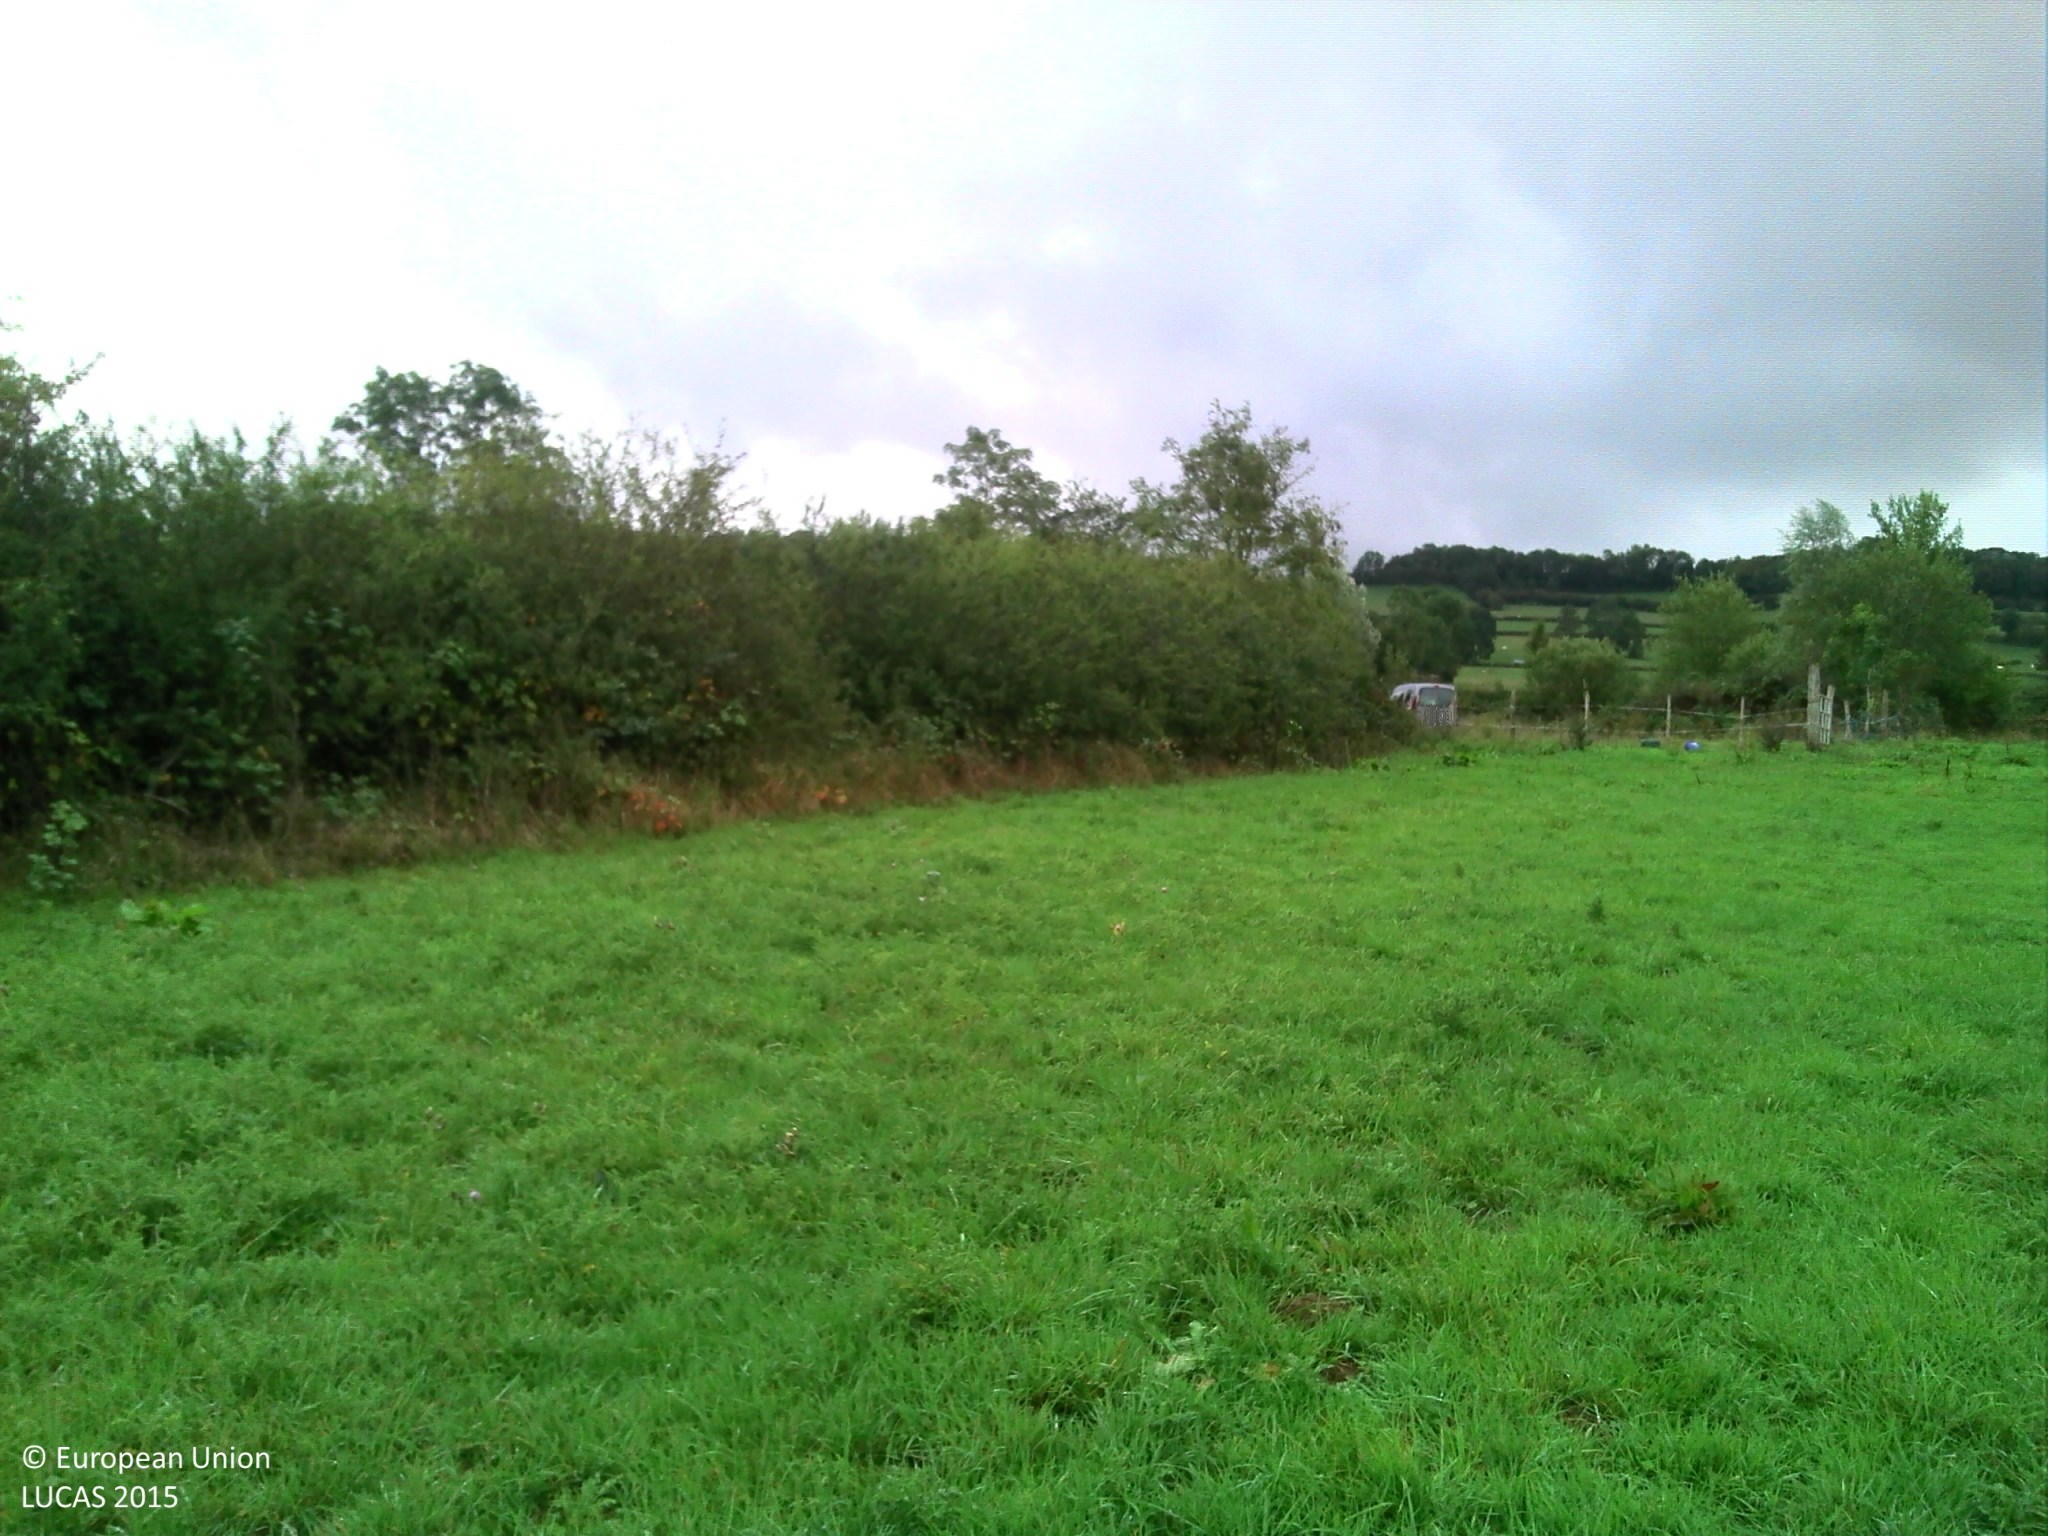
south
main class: Grassland
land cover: Grassland without tree/shrub cover
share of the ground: > 75 %
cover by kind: herbaceous plants 100 %
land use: Agriculture (excluding fallow land and kitchen gardens)
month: September
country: FR
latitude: 47.2339
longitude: 4.4121
